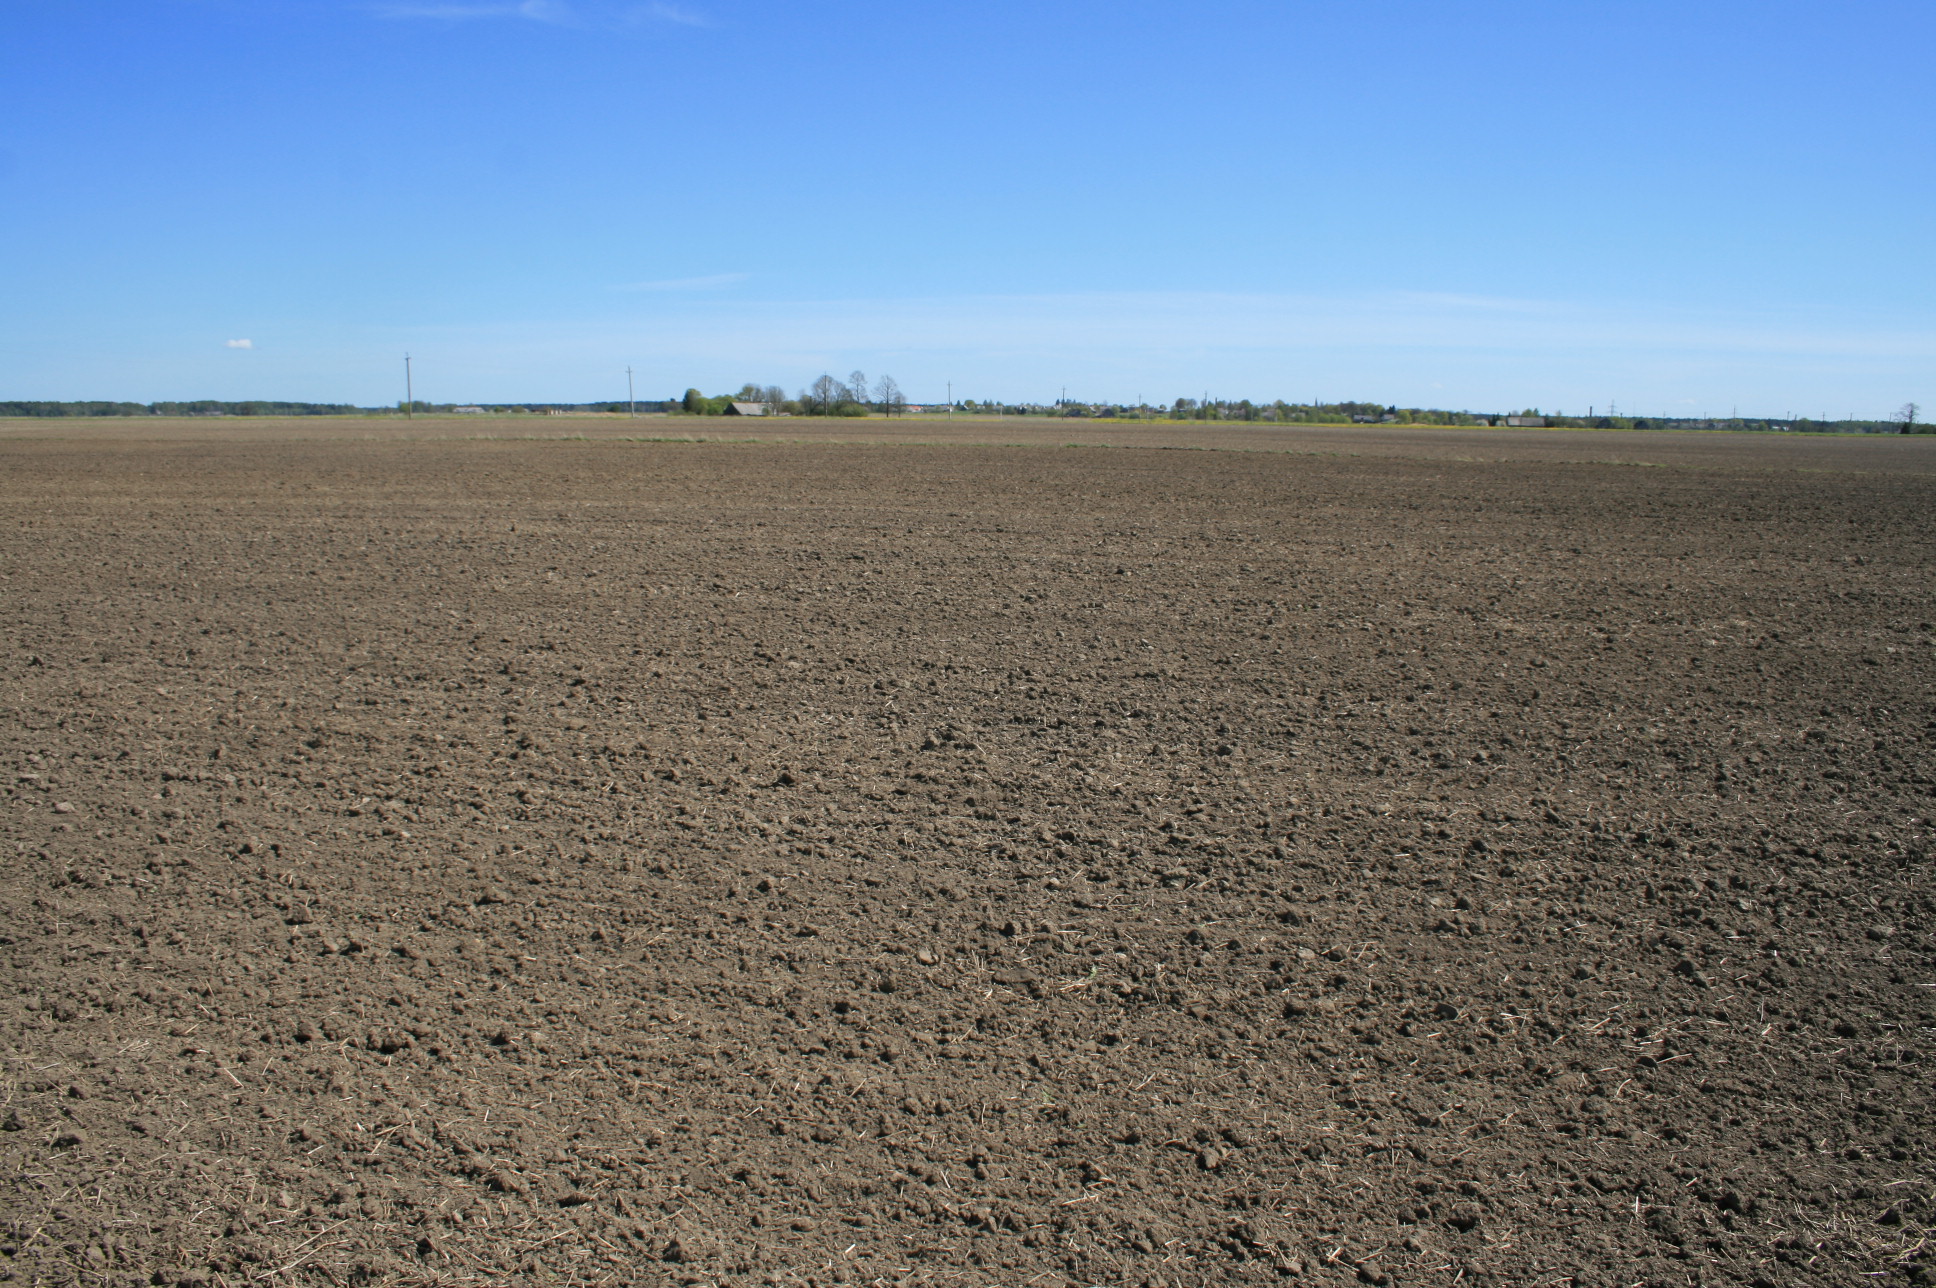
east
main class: Cropland
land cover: Barley
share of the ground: < 10 %
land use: Agriculture (excluding fallow land and kitchen gardens)
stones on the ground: < 10 %
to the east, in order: Barley; Common wheat
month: May
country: LT
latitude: 56.0804
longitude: 21.3701
